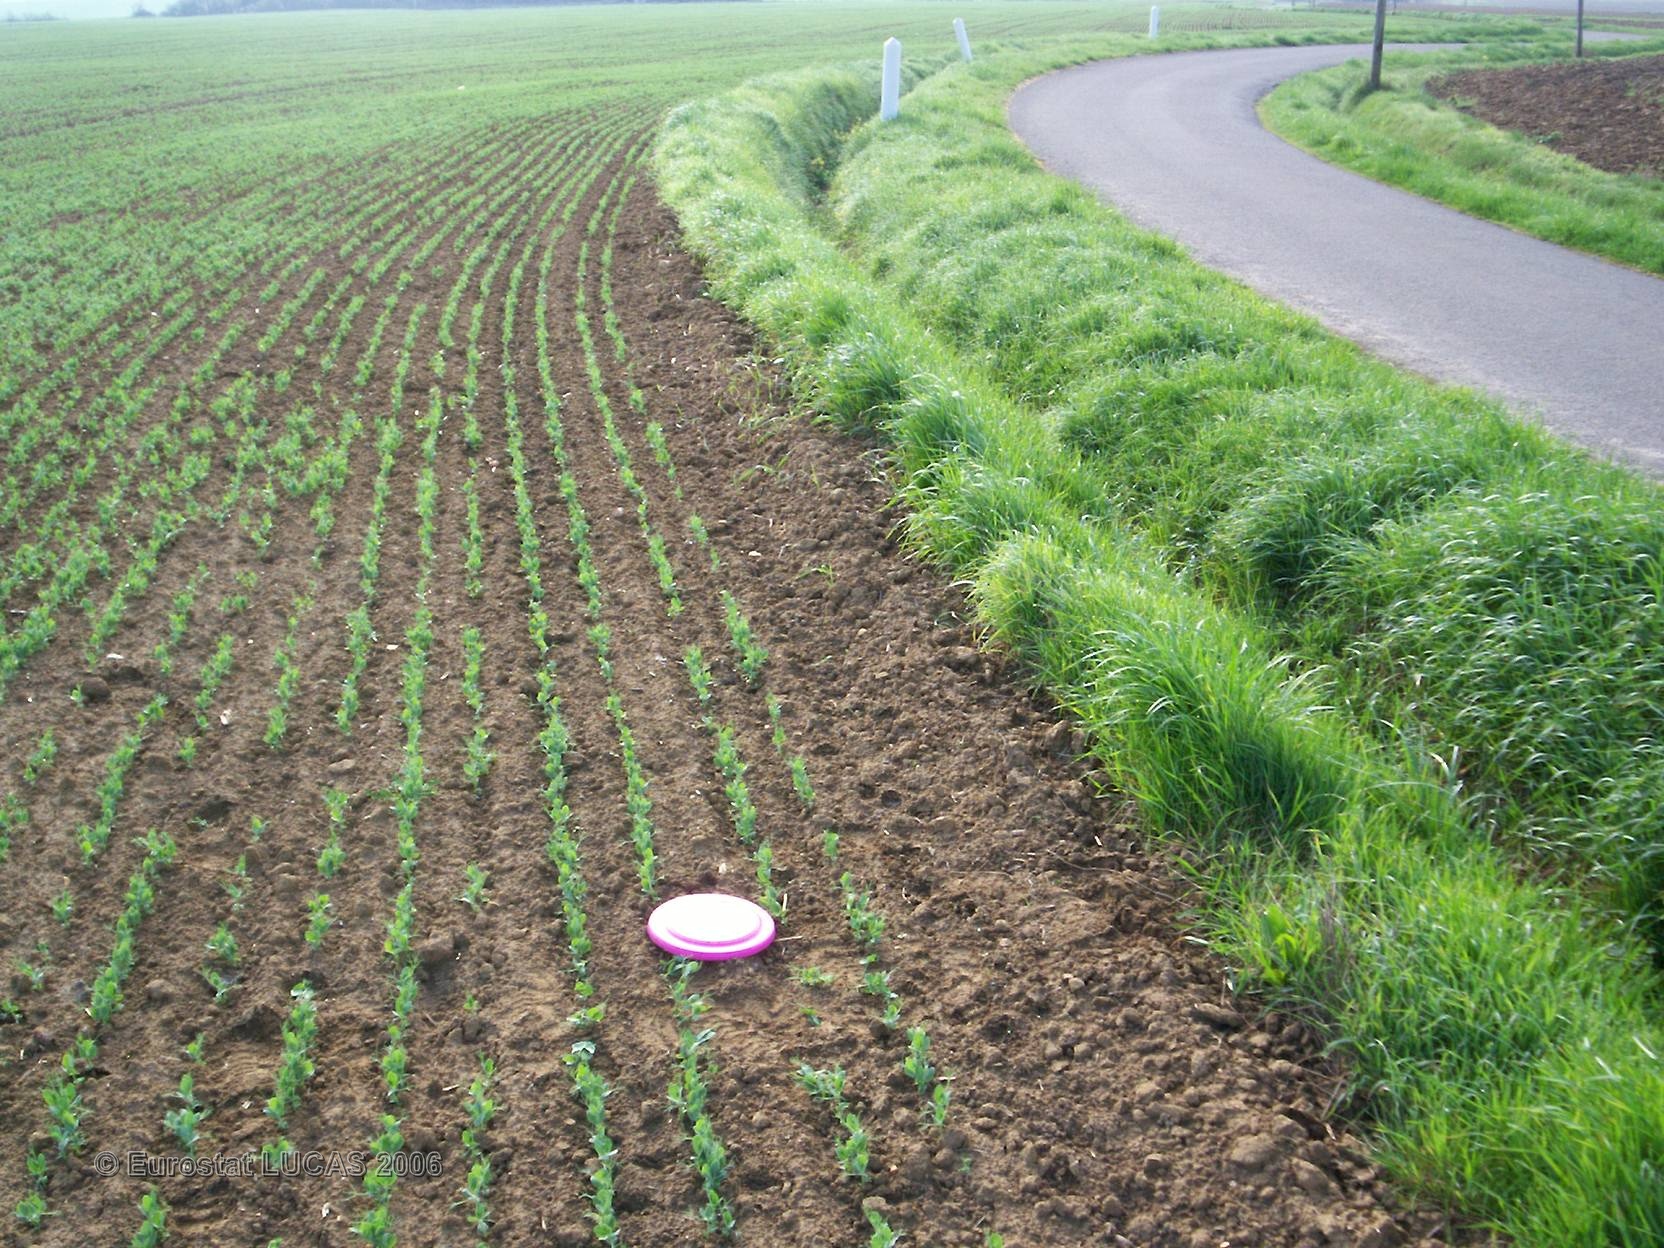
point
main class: Cropland
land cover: Dry pulses
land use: Agriculture (excluding fallow land and kitchen gardens)
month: April
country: FR
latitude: 48.2246
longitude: 0.2413
